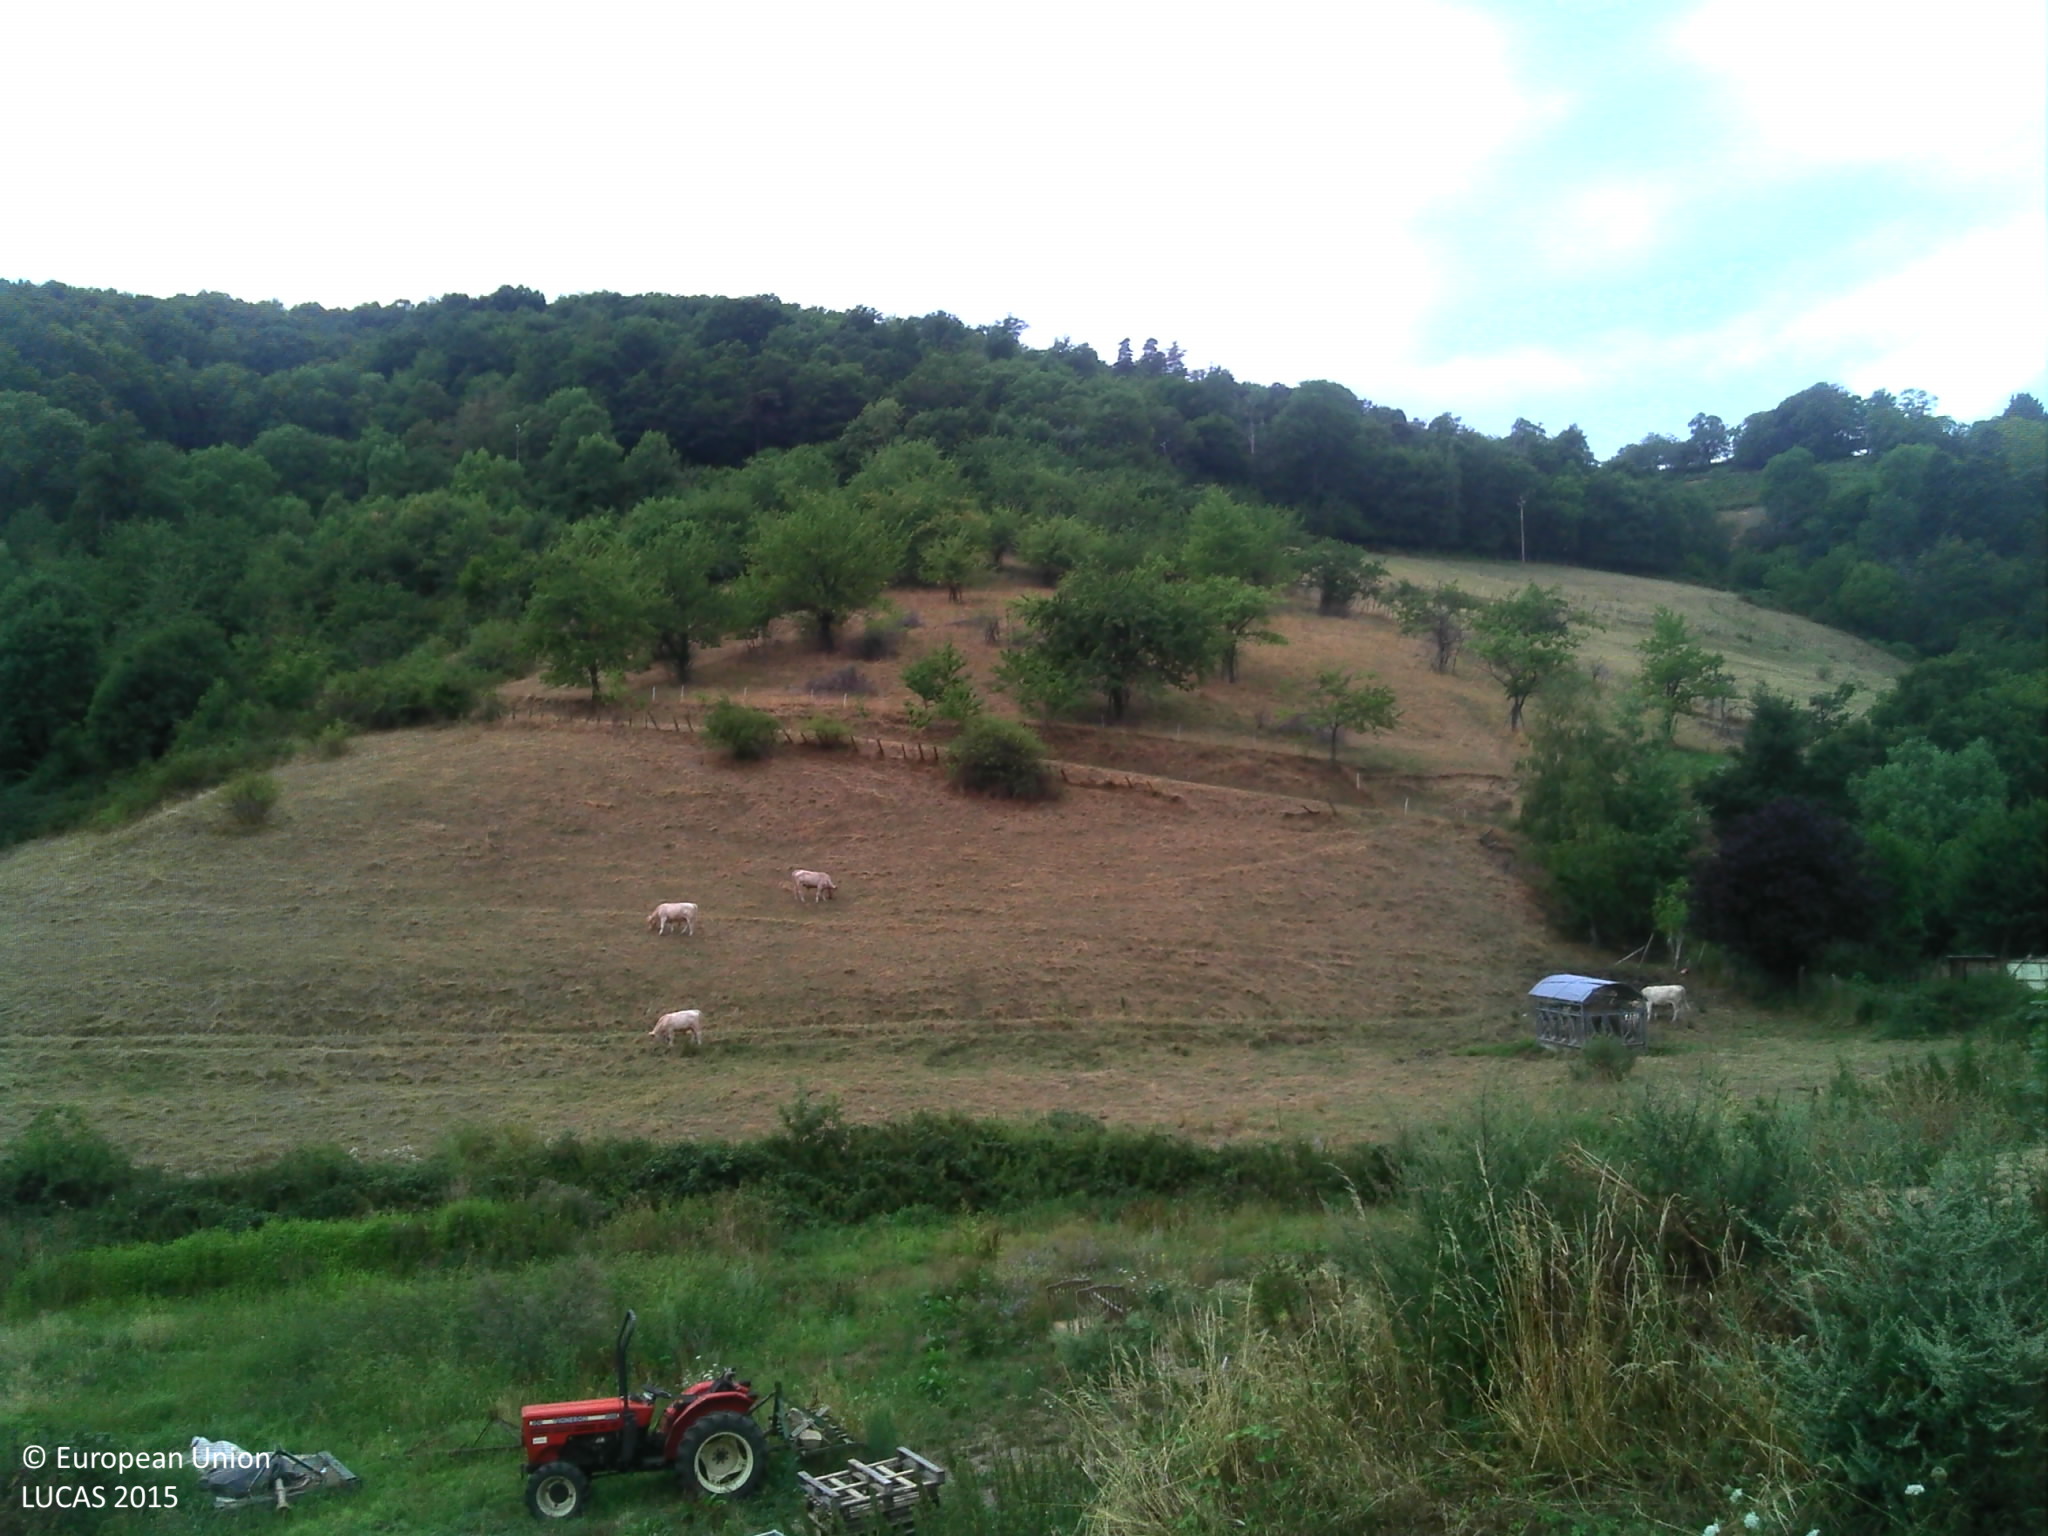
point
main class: Cropland
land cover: Cherry fruit
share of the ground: > 75 %
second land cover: Grassland without tree/shrub cover
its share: 25 - 50 %
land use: Agriculture (excluding fallow land and kitchen gardens)
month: August
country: FR
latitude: 45.6552
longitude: 4.6009
